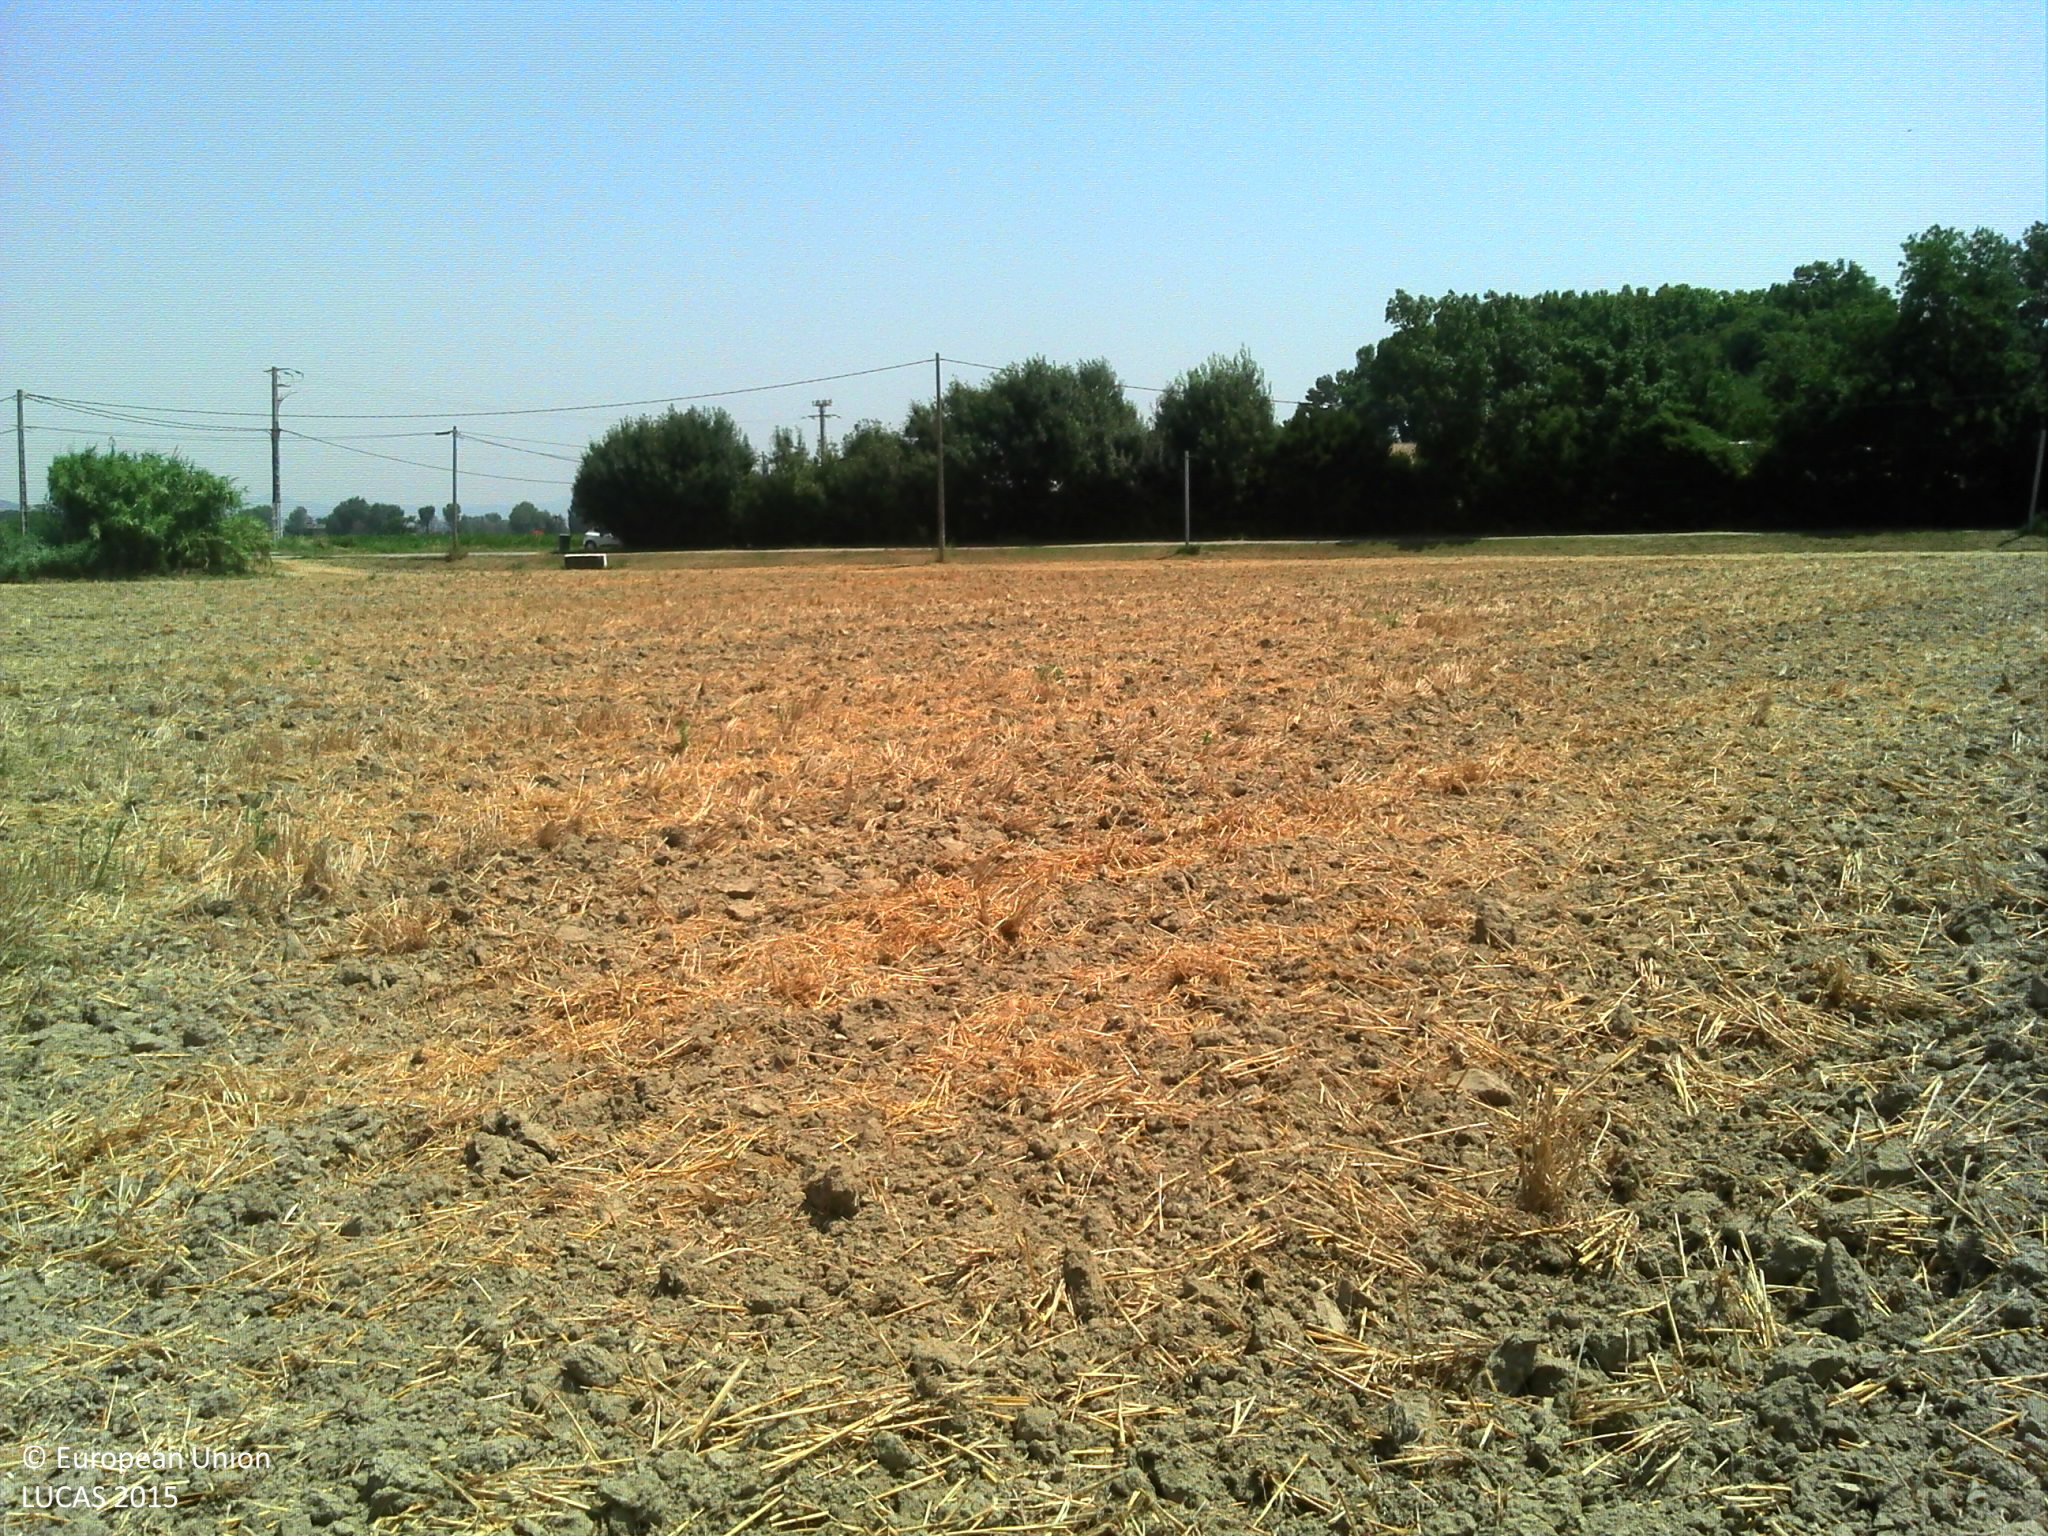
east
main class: Cropland
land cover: Barley
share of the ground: > 75 %
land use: Agriculture (excluding fallow land and kitchen gardens)
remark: Harvested field
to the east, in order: Barley; Electric lines; Ditches and canals; Electric lines; Grass margins; Paved roads, cycling and walking lanes; Lines of trees; Artificial constructions in urban areas; Abandoned hedges; Rivers and streams; Grass margins; Electric lines; Paved roads, cycling and walking lanes; Grass margins; Electric lines
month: July
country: FR
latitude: 44.3944
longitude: 4.6715
